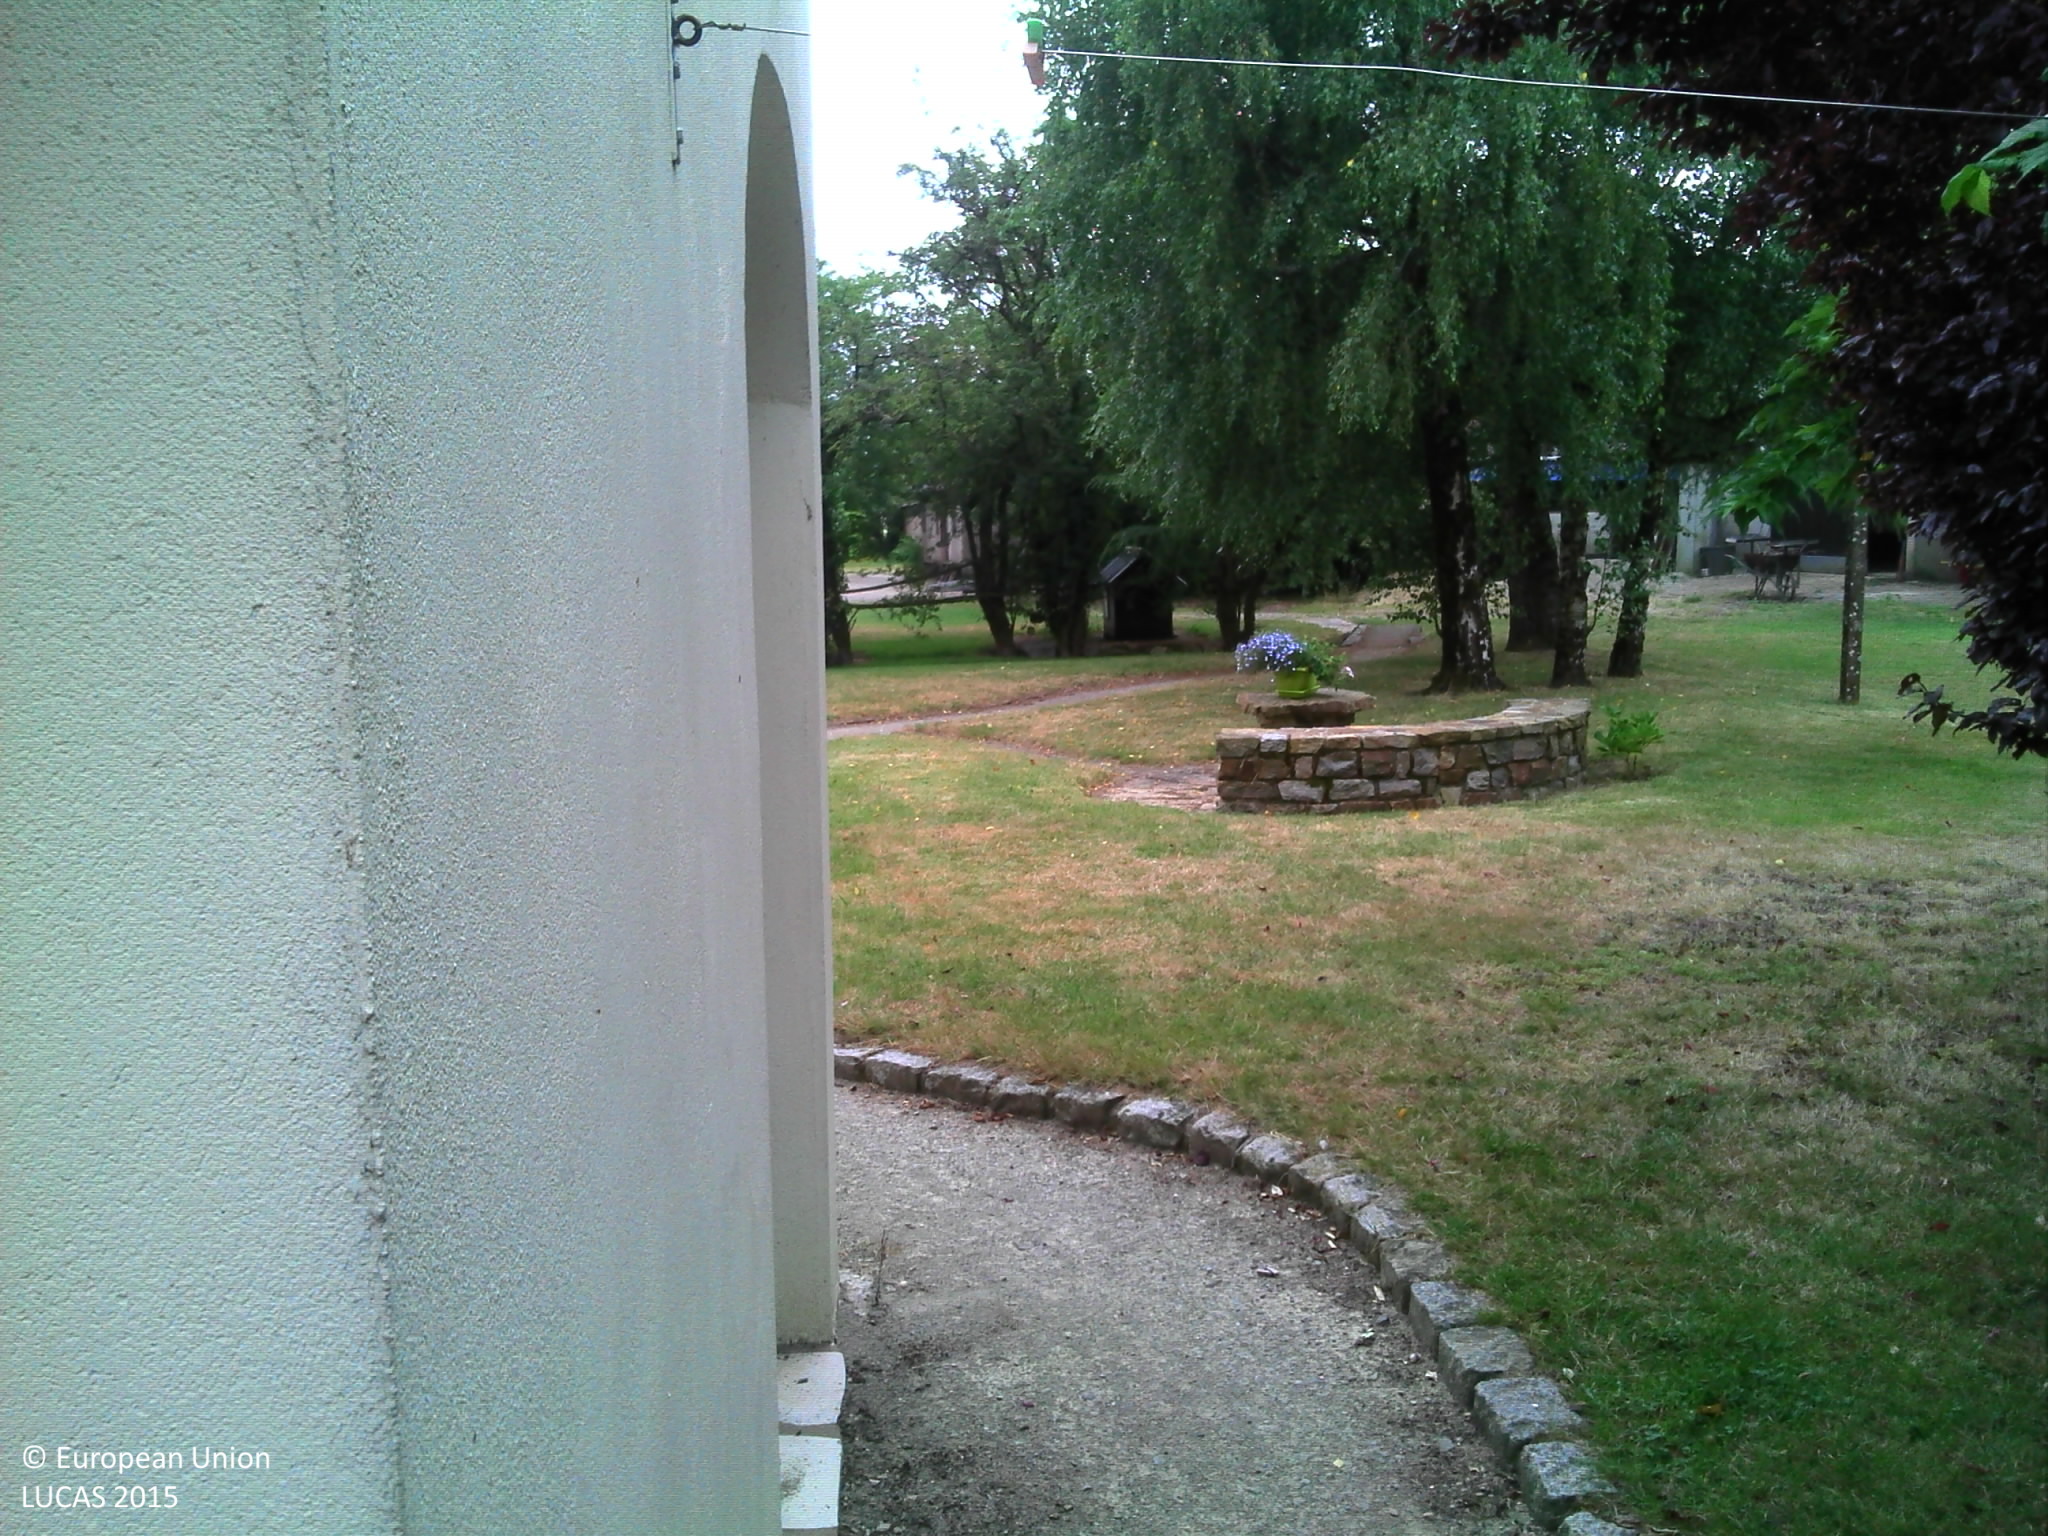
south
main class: Grassland
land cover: Grassland with sparse tree/shrub cover
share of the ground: > 75 %
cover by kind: herbaceous plants 95 %, broadleaved forest trees 5 %
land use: Residential
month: July
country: FR
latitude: 47.1449
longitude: -1.6874
